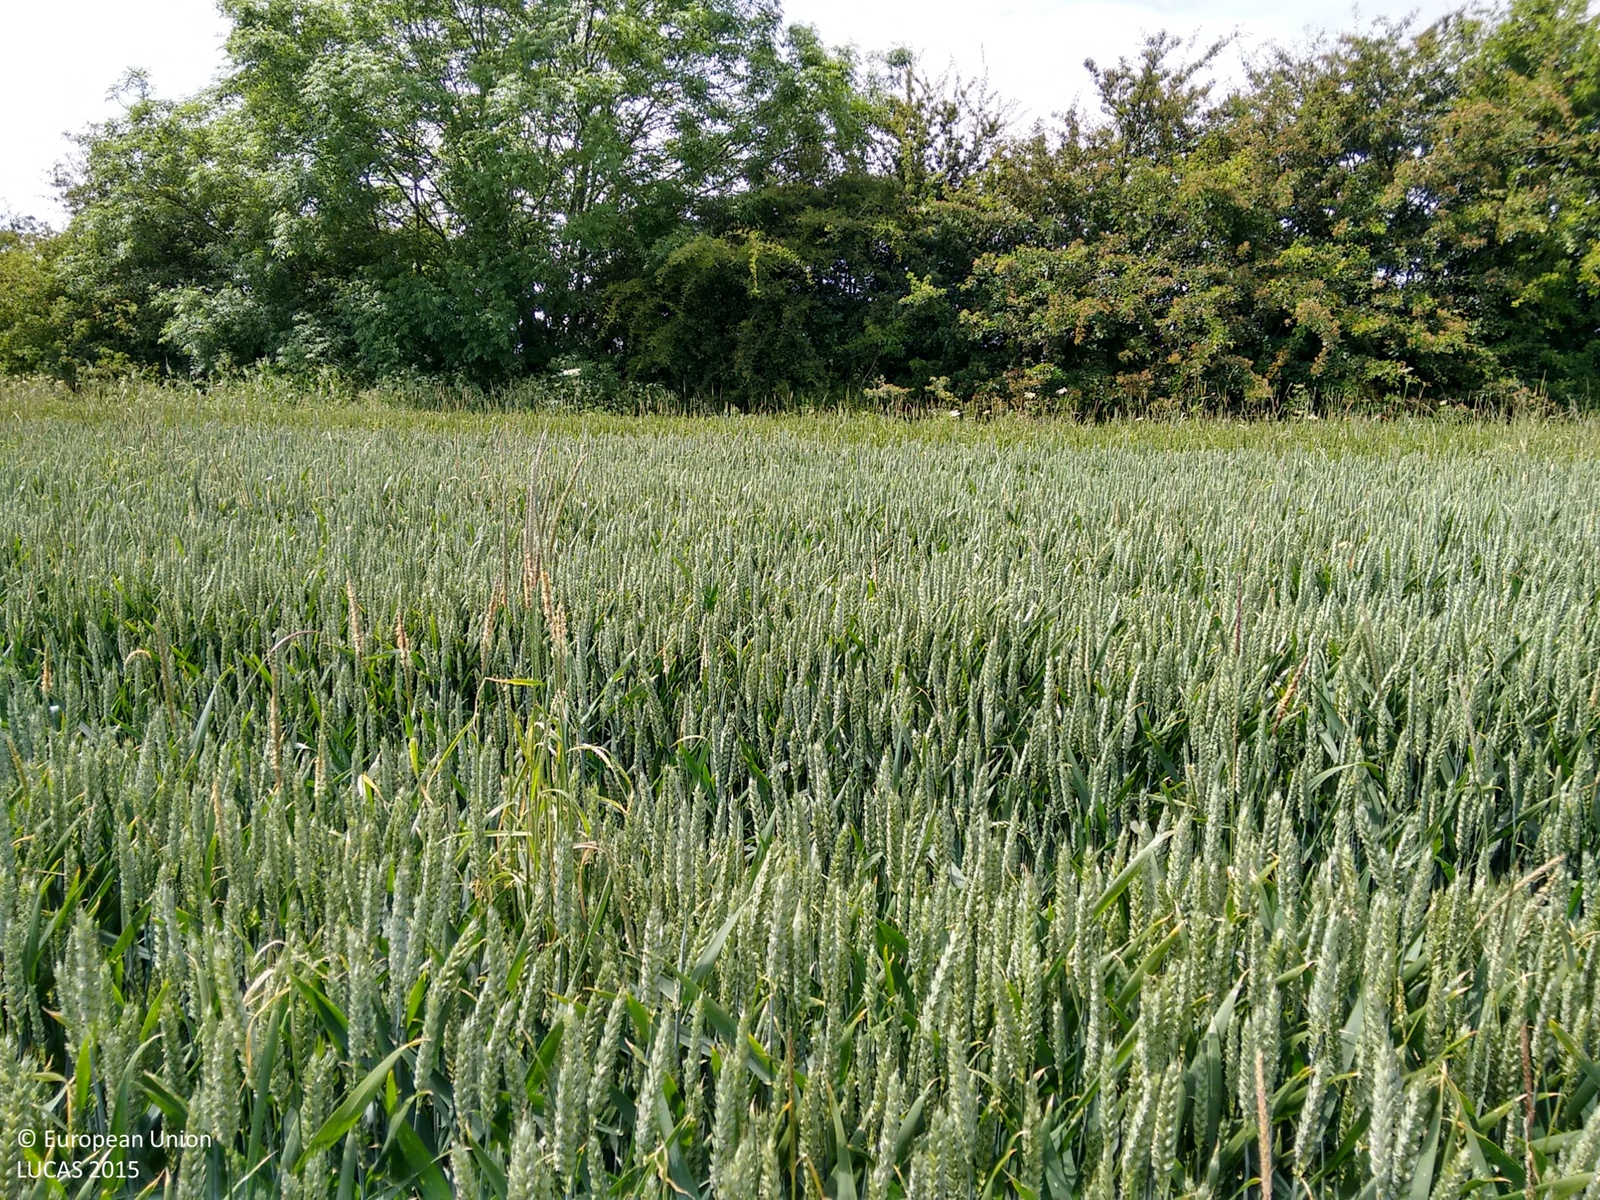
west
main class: Cropland
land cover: Common wheat
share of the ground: > 75 %
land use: Agriculture (excluding fallow land and kitchen gardens)
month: June
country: GB
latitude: 53.0962
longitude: -0.6272
